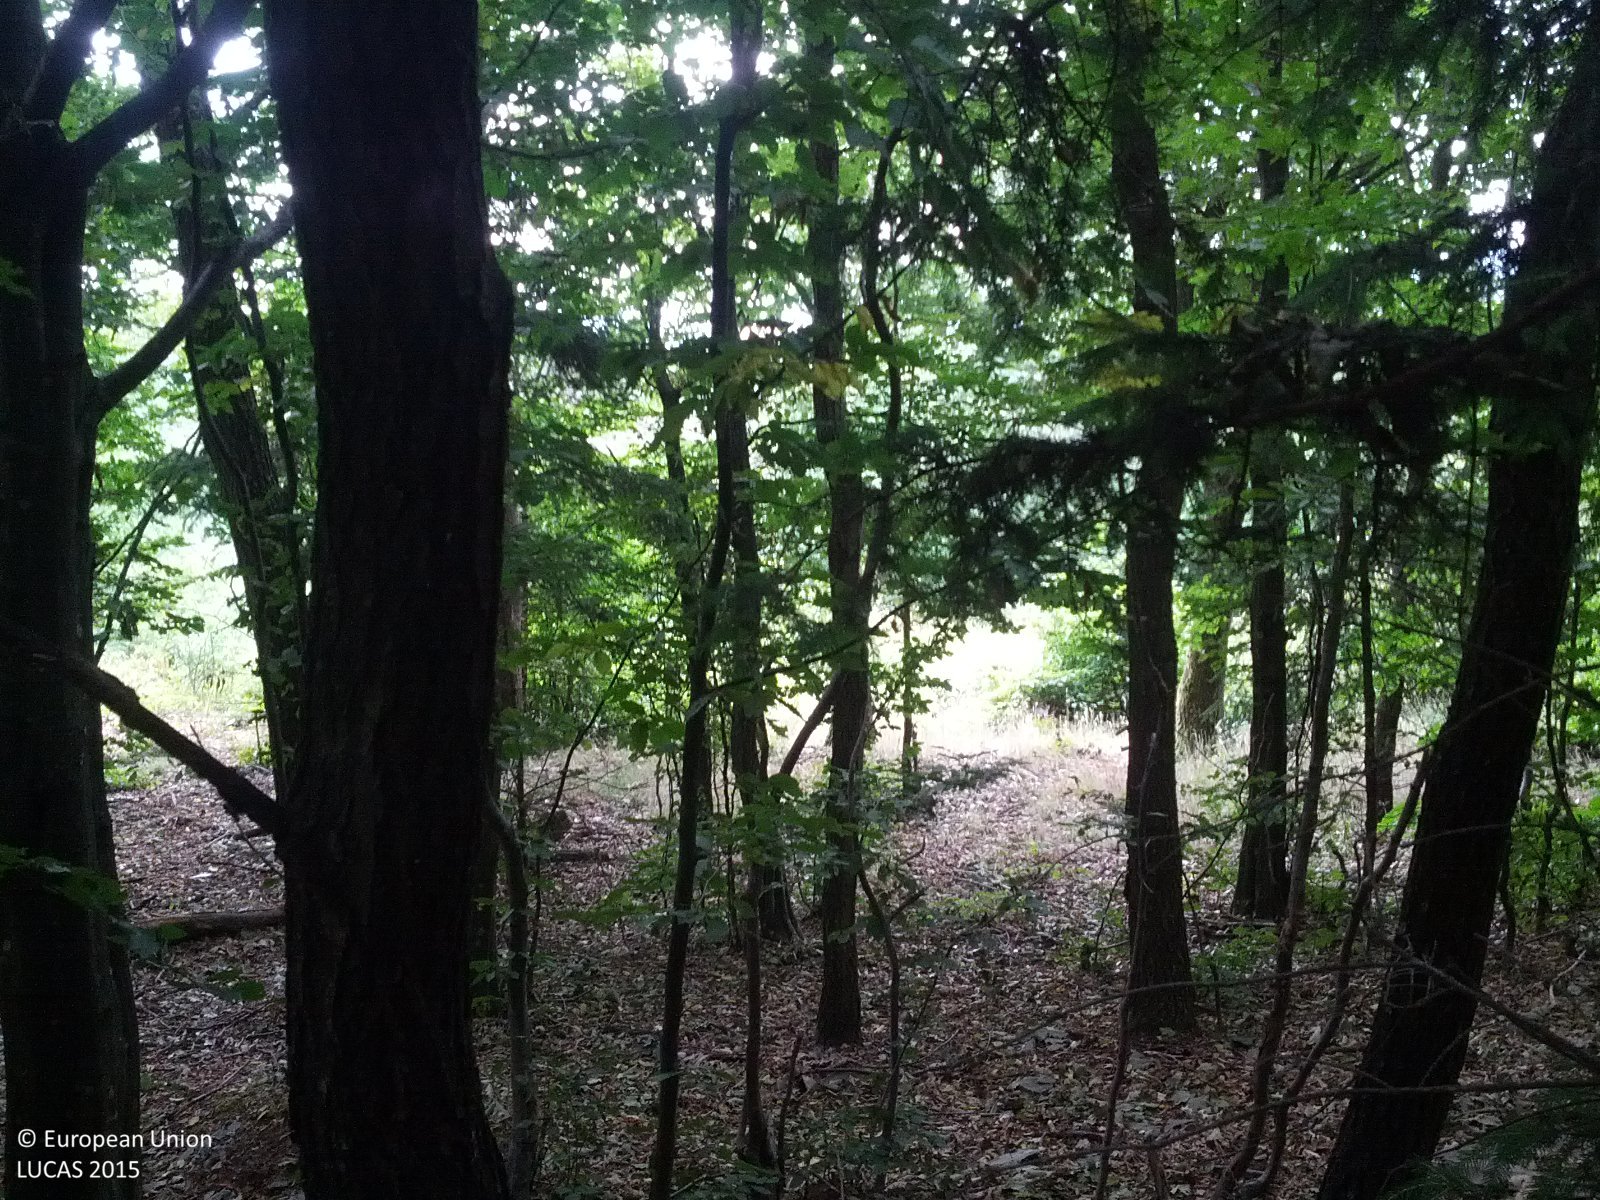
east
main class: Woodland
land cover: Spruce dominated mixed woodland
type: alpine coniferous forest
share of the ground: > 75 %
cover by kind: coniferous forest trees 55 %, broadleaved forest trees 35 %, shrubs 5 %, unconsolidated bare surface 5 %
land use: Forestry
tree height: > 5 m
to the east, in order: Spruce dominated mixed woodland; Groves; Tracks; Groves; Broadleaved woodland; Shrubland with sparse tree cover; Grass margins; Tracks; Grass margins; Pine dominated mixed woodland; Spruce dominated mixed woodland
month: July
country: AT
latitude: 47.3143
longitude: 16.4190
